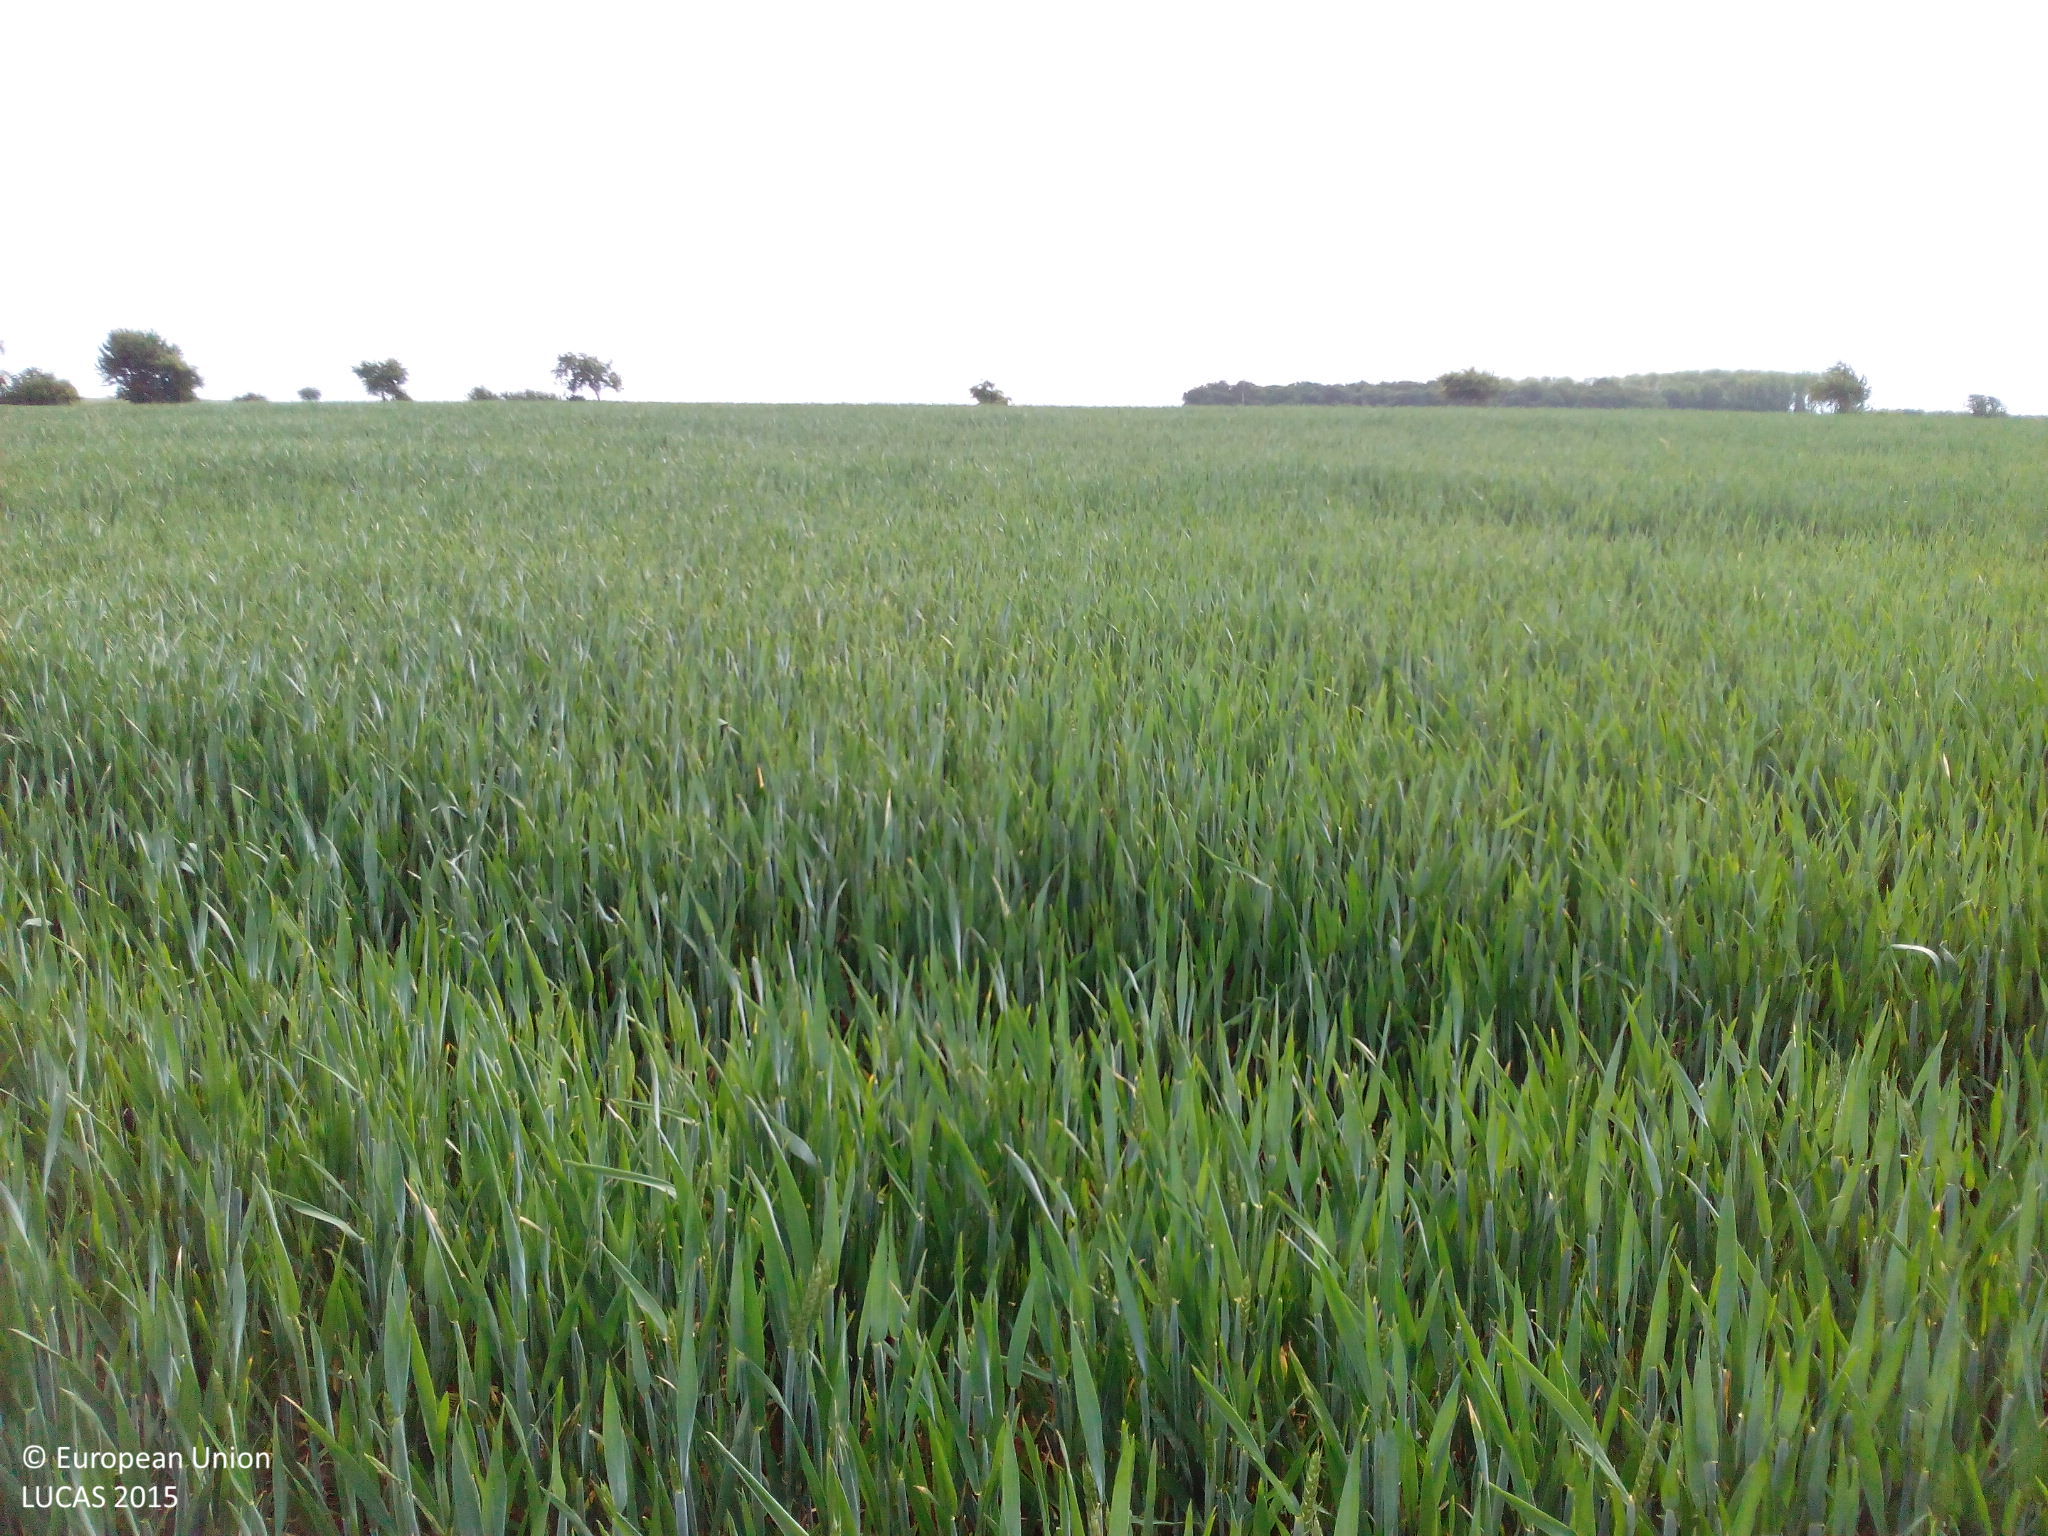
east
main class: Cropland
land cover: Common wheat
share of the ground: > 75 %
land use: Agriculture (excluding fallow land and kitchen gardens)
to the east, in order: Common wheat; Grass margins; Tracks; Grass margins; Lines of trees; Ditches and canals; Grass margins; Common wheat
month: June
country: DE
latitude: 51.5340
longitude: 8.0253
